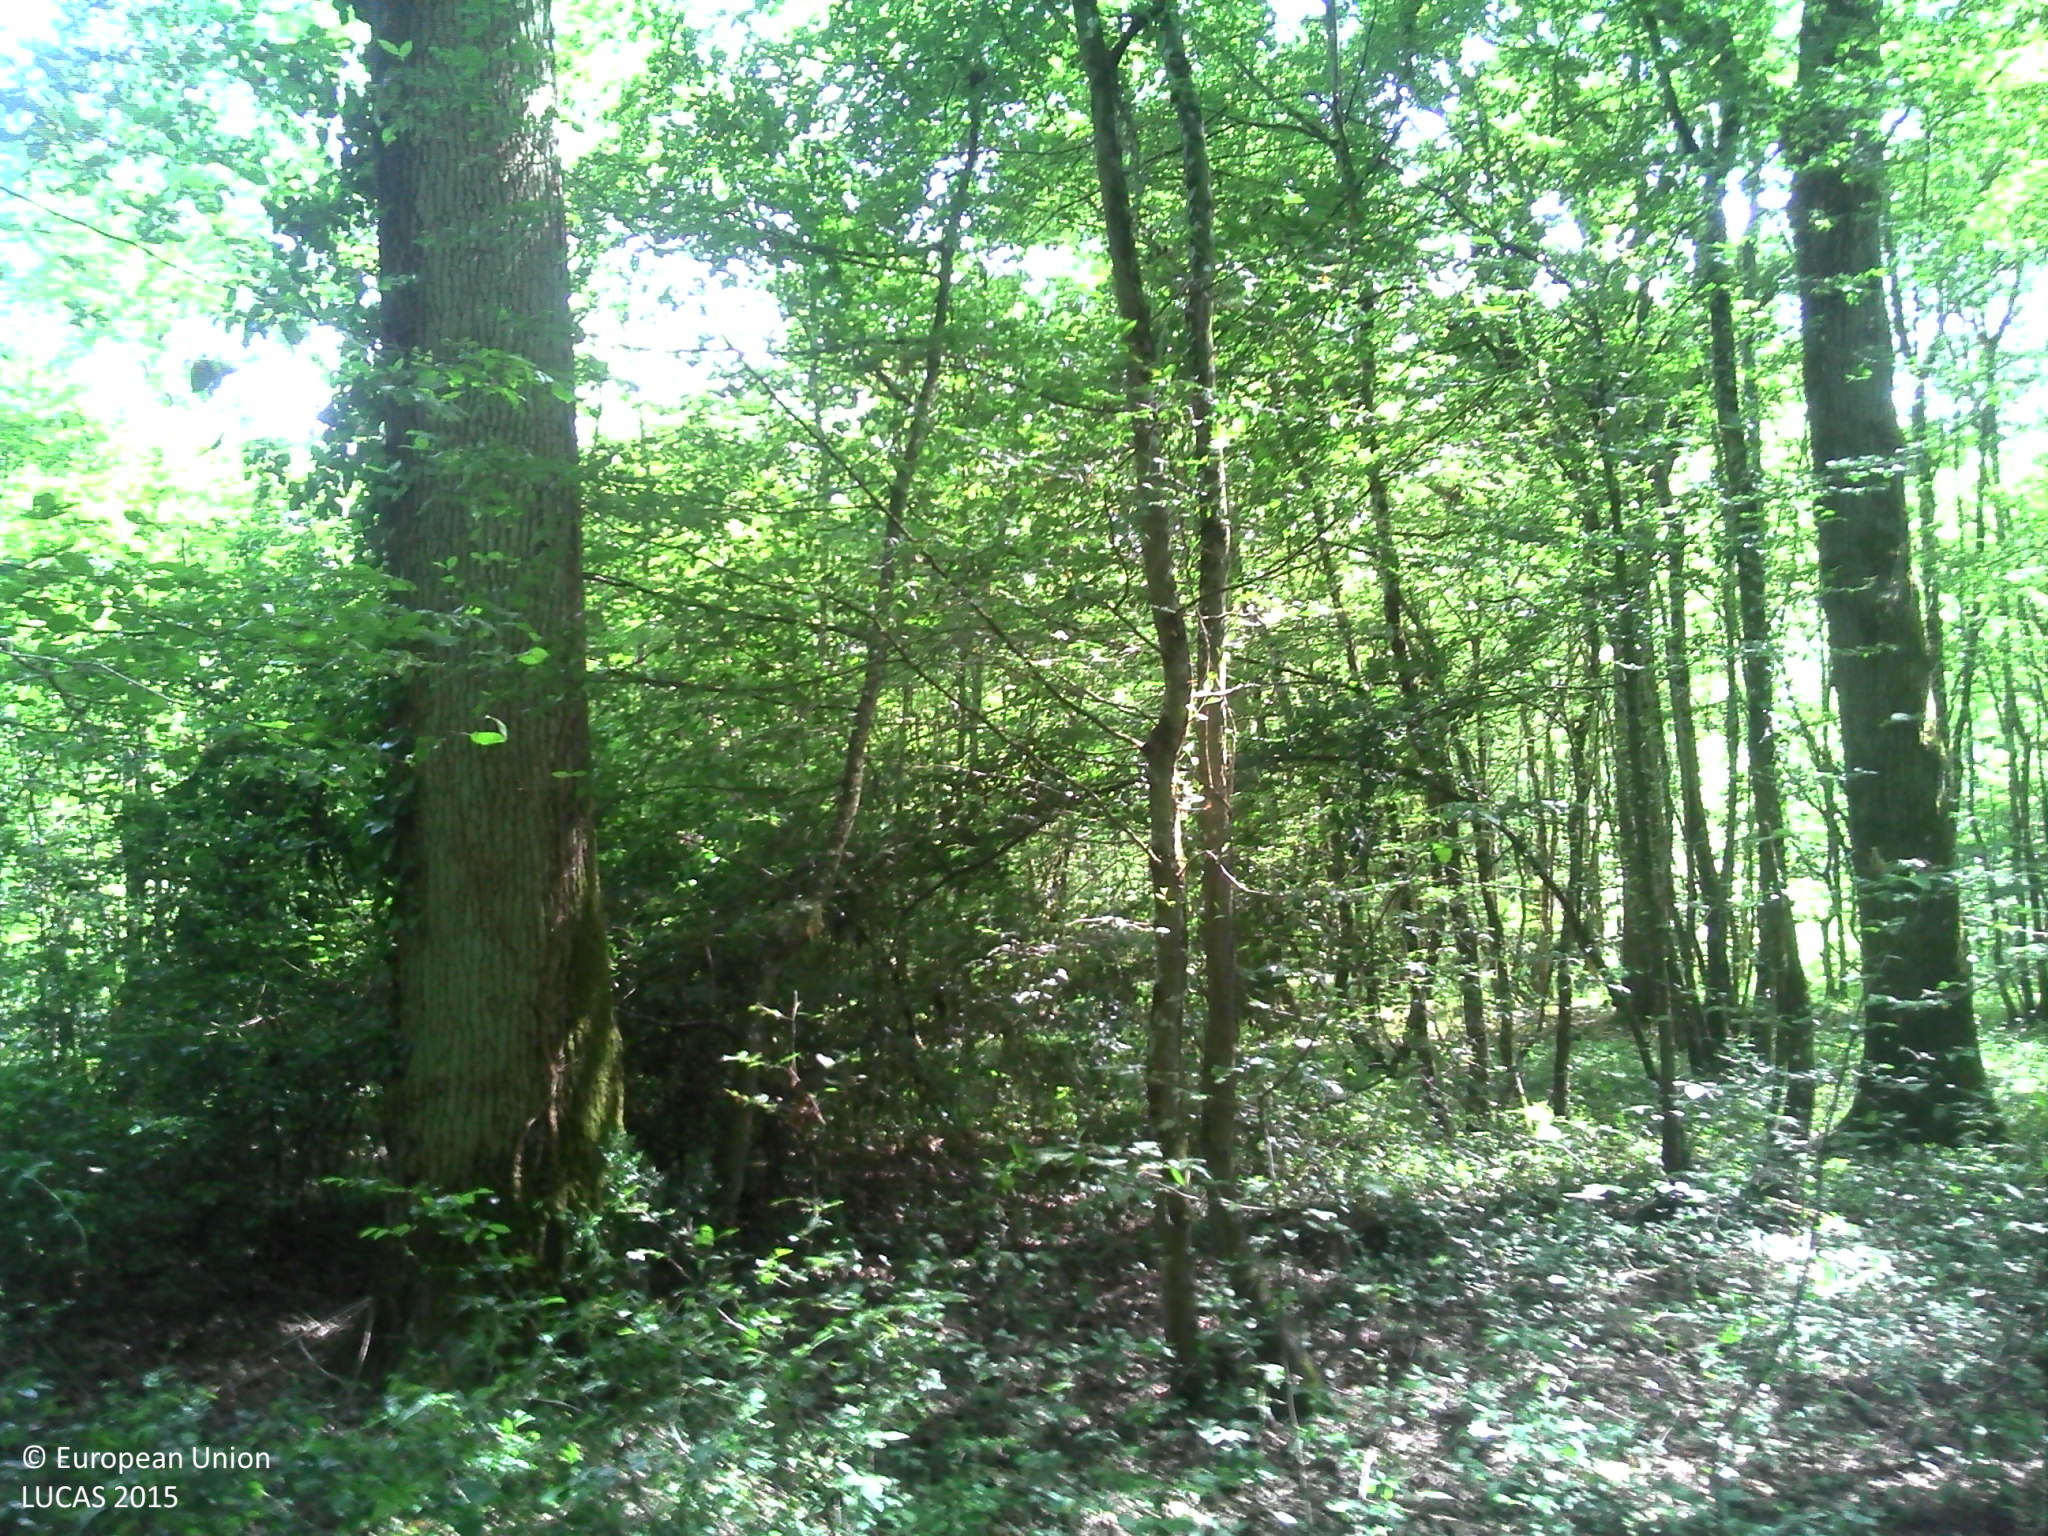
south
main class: Woodland
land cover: Broadleaved woodland
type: mesophytic deciduous forest
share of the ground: > 75 %
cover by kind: broadleaved forest trees 95 %, herbaceous plants 5 %
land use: Forestry
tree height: > 5 m
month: June
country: FR
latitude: 47.7516
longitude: 2.5082
